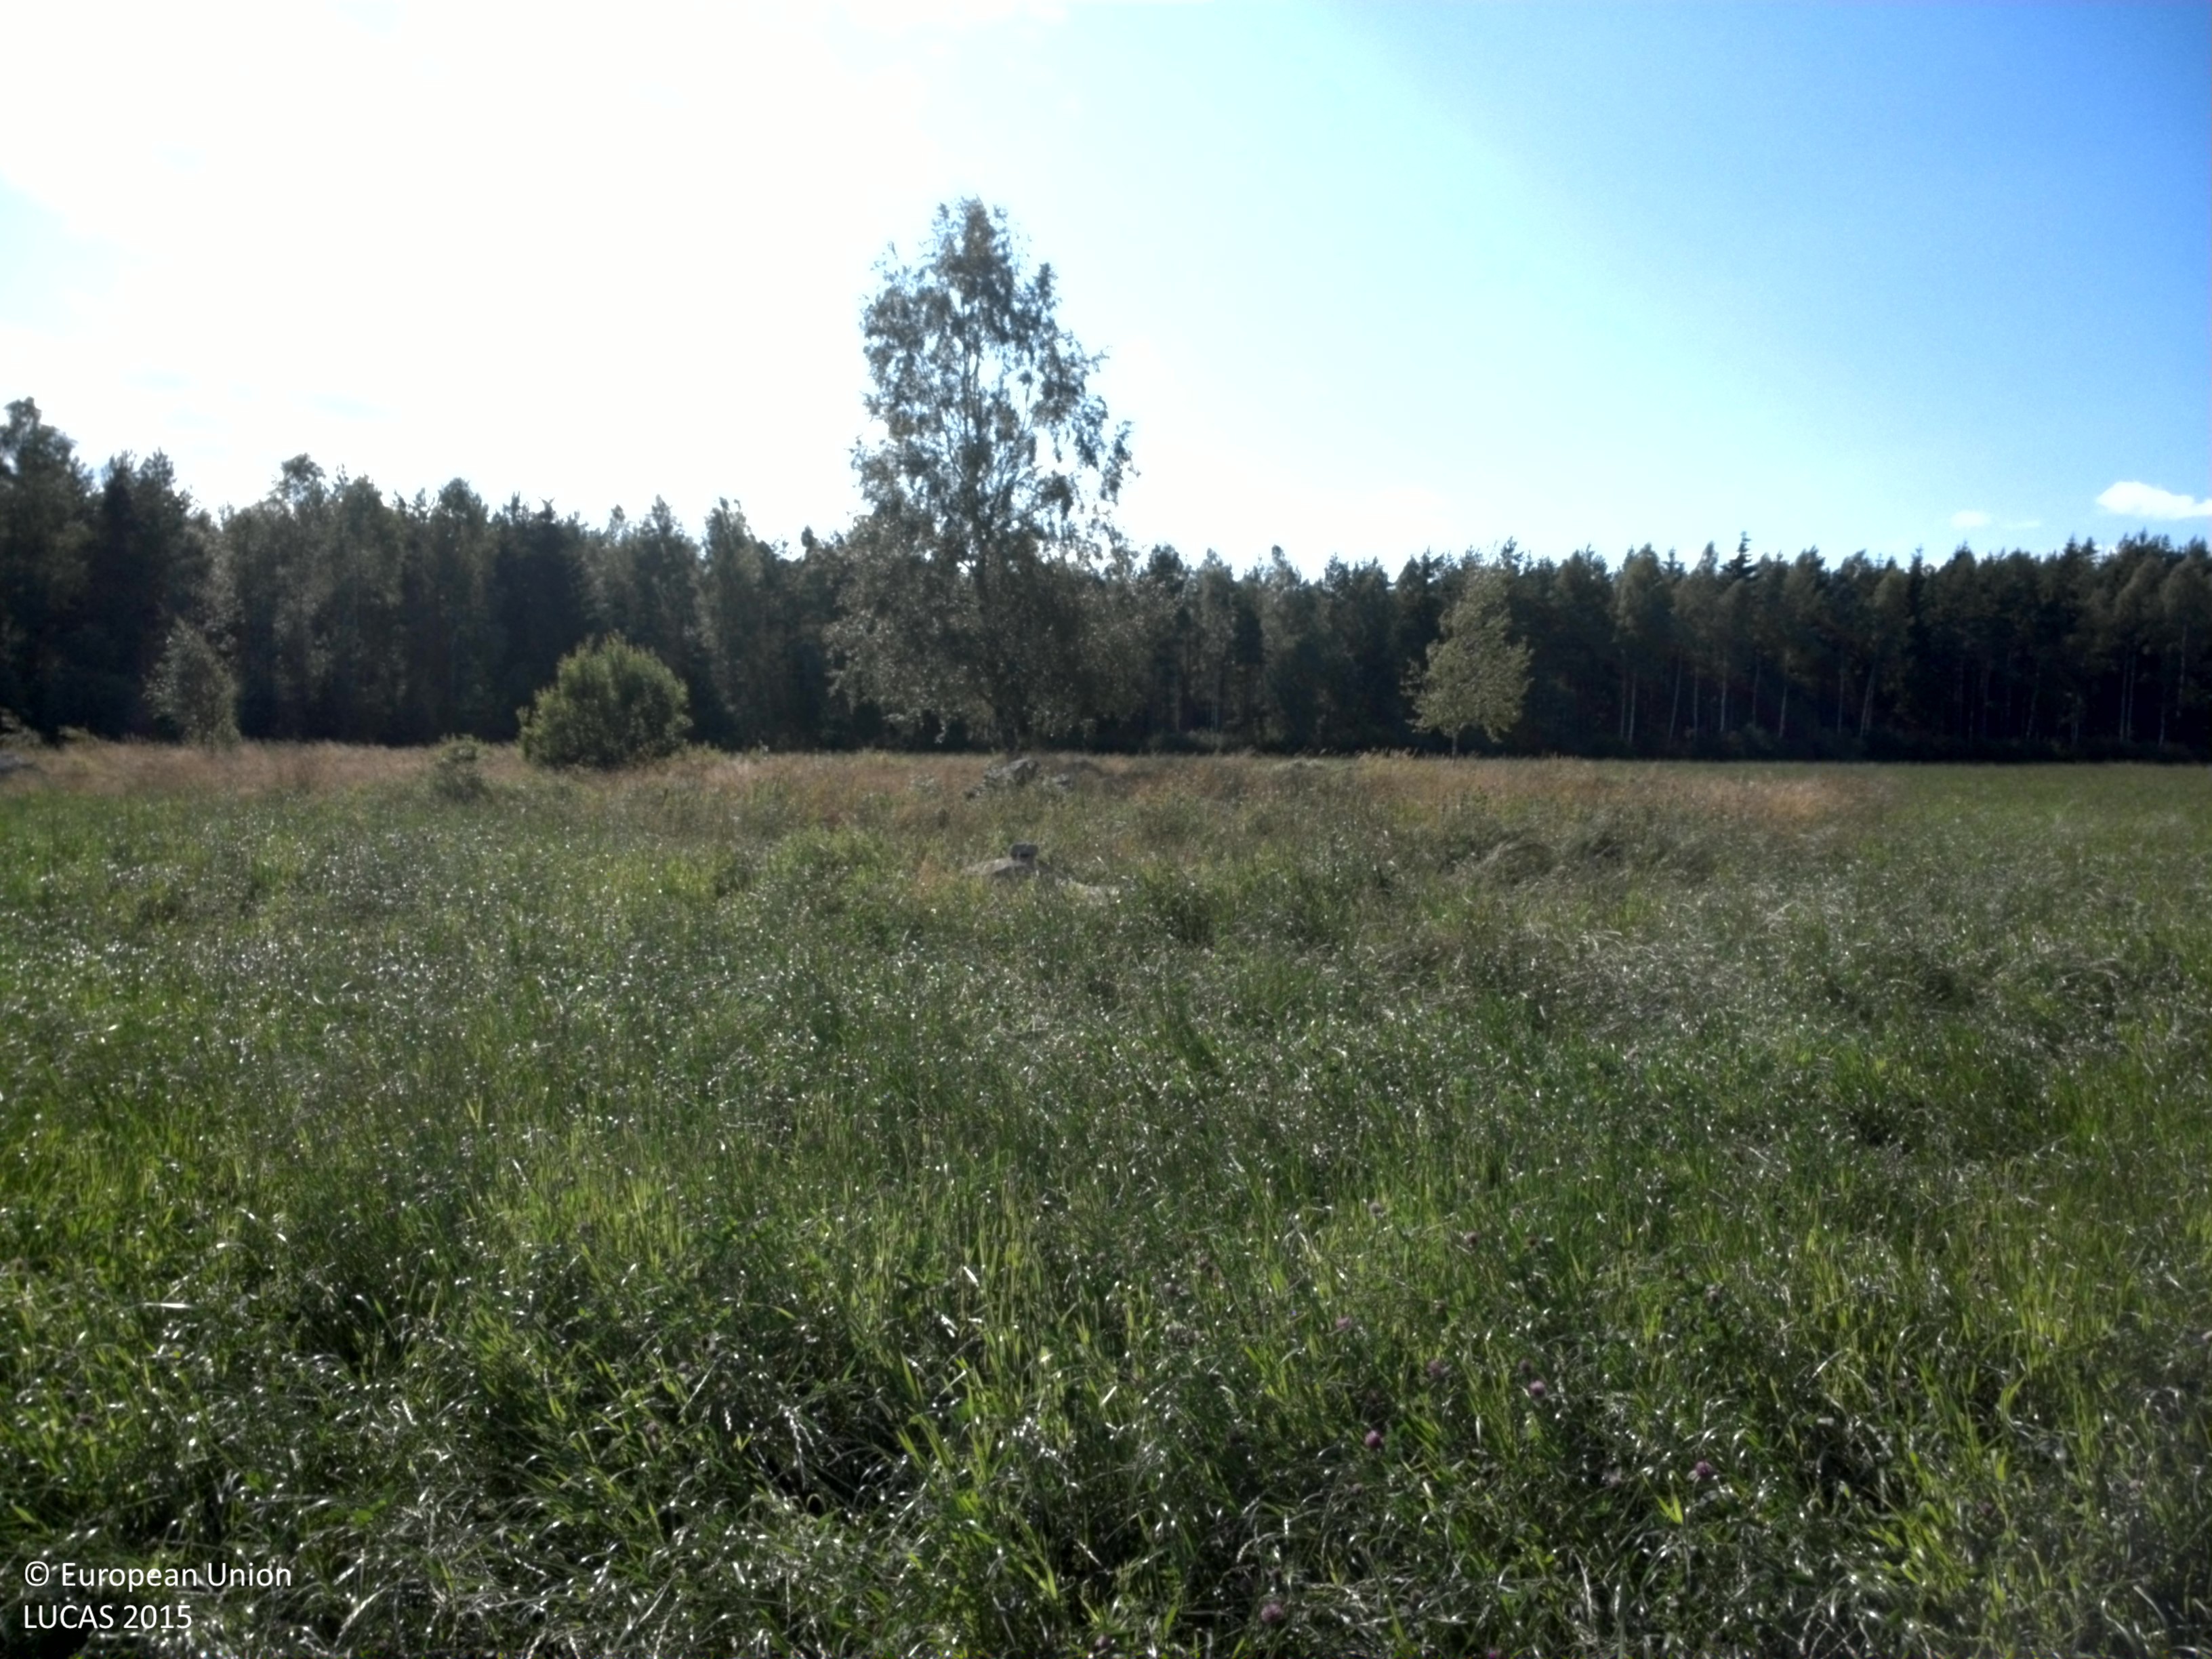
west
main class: Cropland
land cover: Temporary grasslands
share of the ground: > 75 %
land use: Agriculture (excluding fallow land and kitchen gardens)
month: July
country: SE
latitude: 58.6272
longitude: 14.0403
